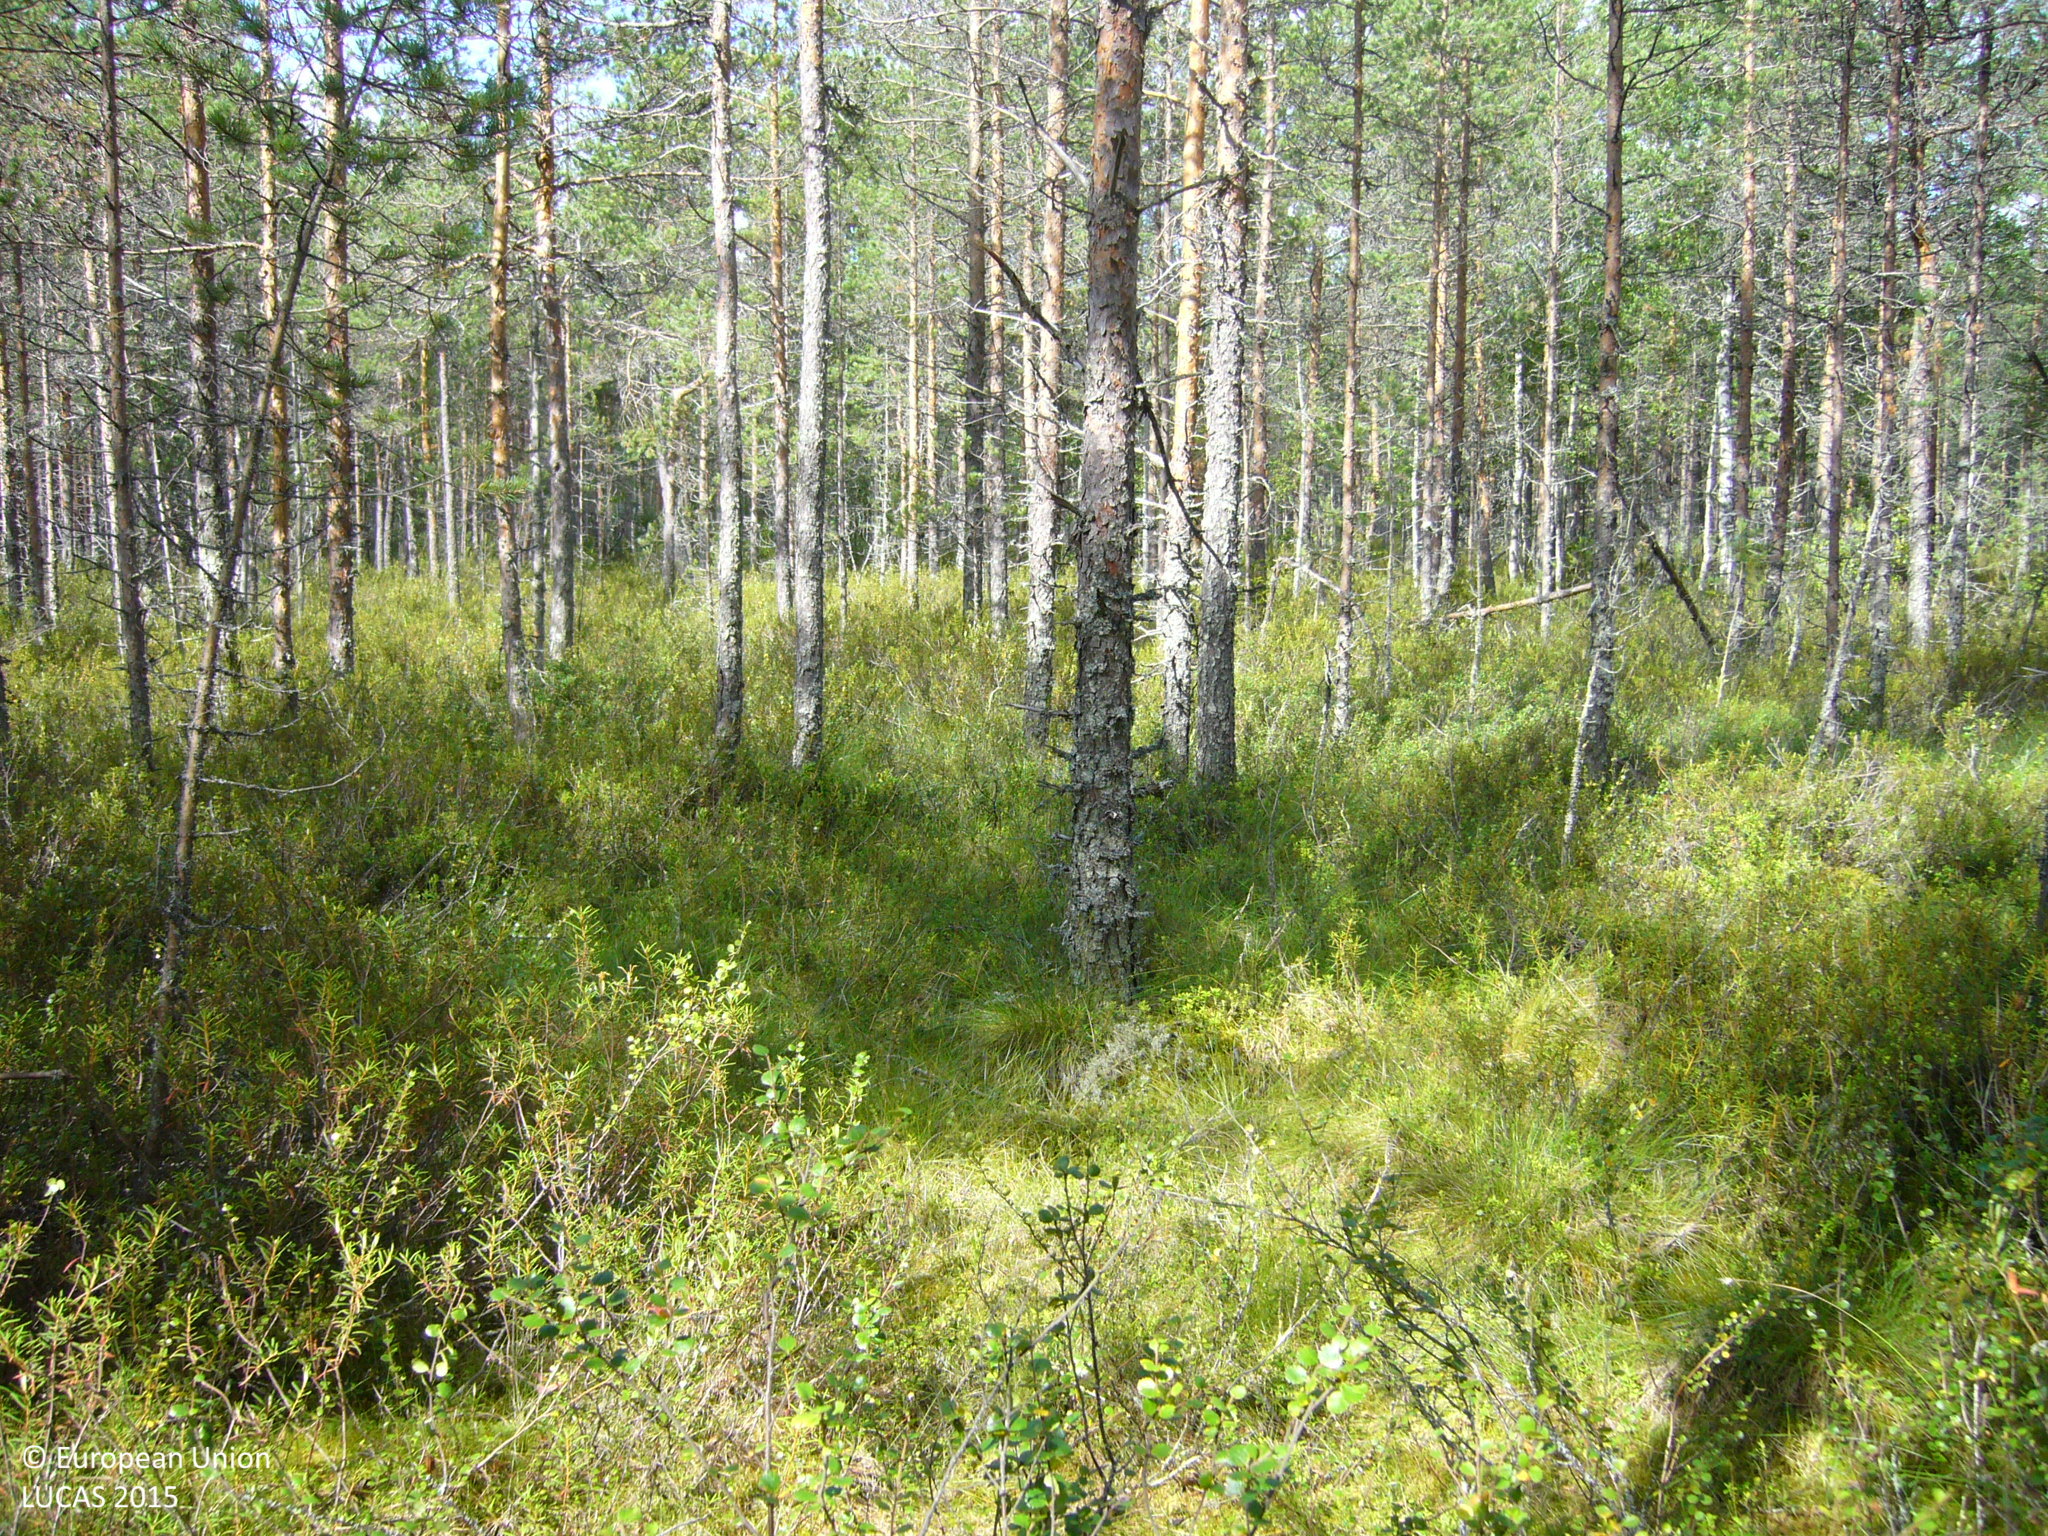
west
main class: Woodland
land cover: Pine dominated coniferous woodland
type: boreal forest
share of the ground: 50 - 75 %
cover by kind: coniferous forest trees 60 %, shrubs 35 %, broadleaved forest trees 5 %
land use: Forestry
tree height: > 5 m
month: July
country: FI
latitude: 64.0341
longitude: 25.8876
